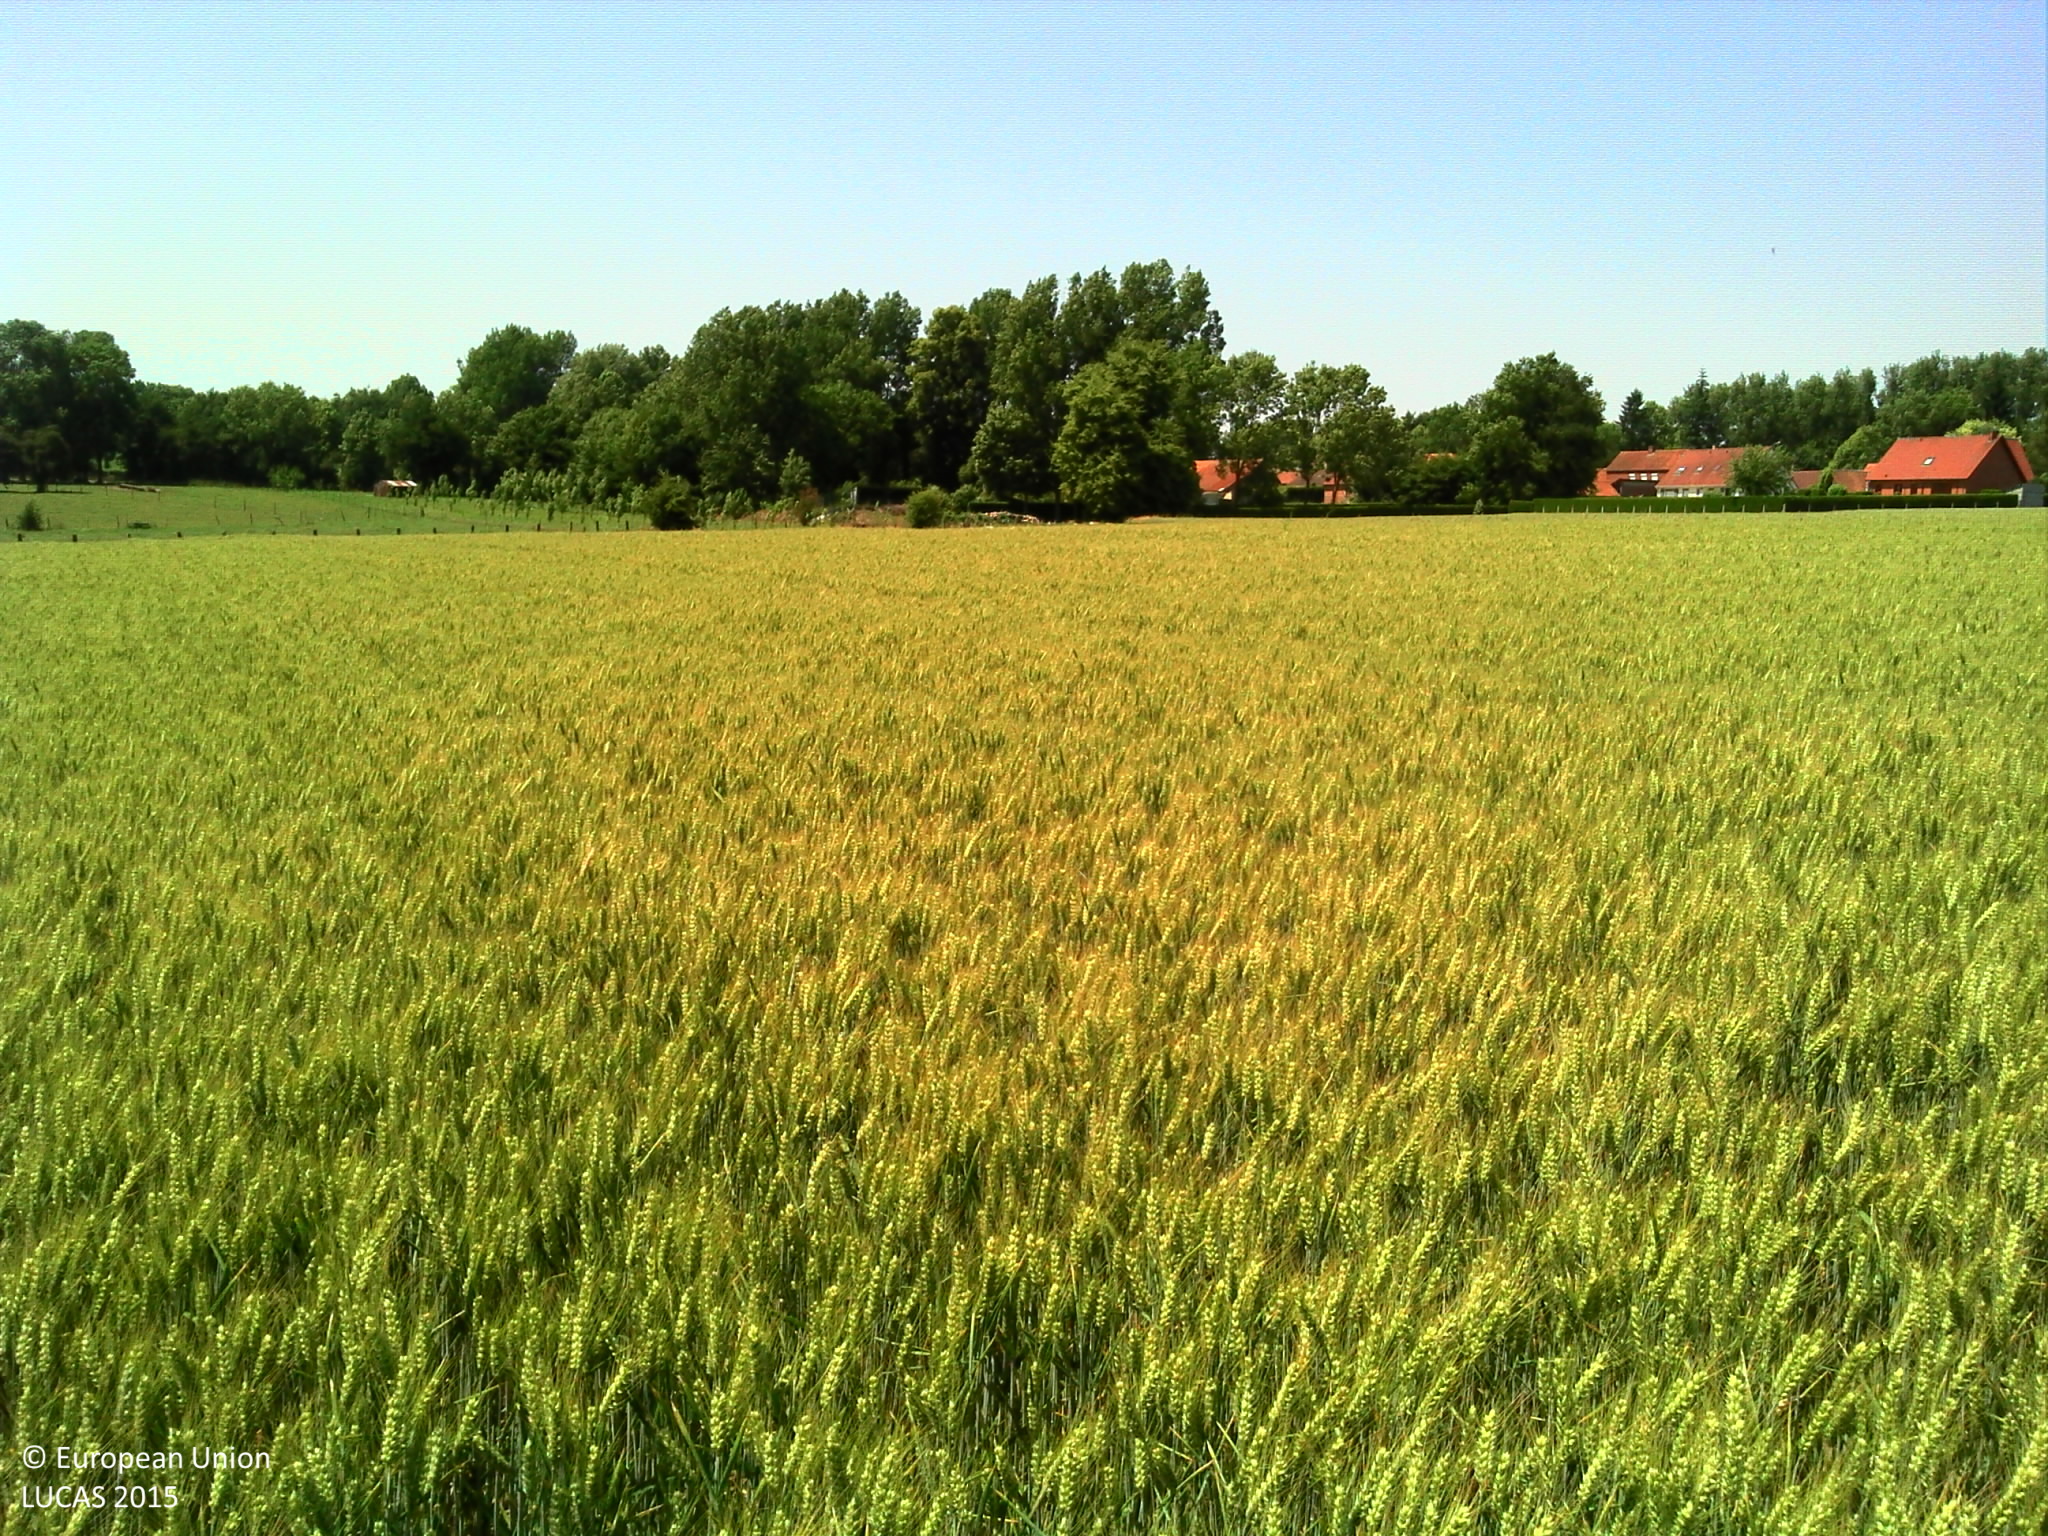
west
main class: Cropland
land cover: Common wheat
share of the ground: > 75 %
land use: Agriculture (excluding fallow land and kitchen gardens)
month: July
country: FR
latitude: 50.2807
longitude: 2.5078
